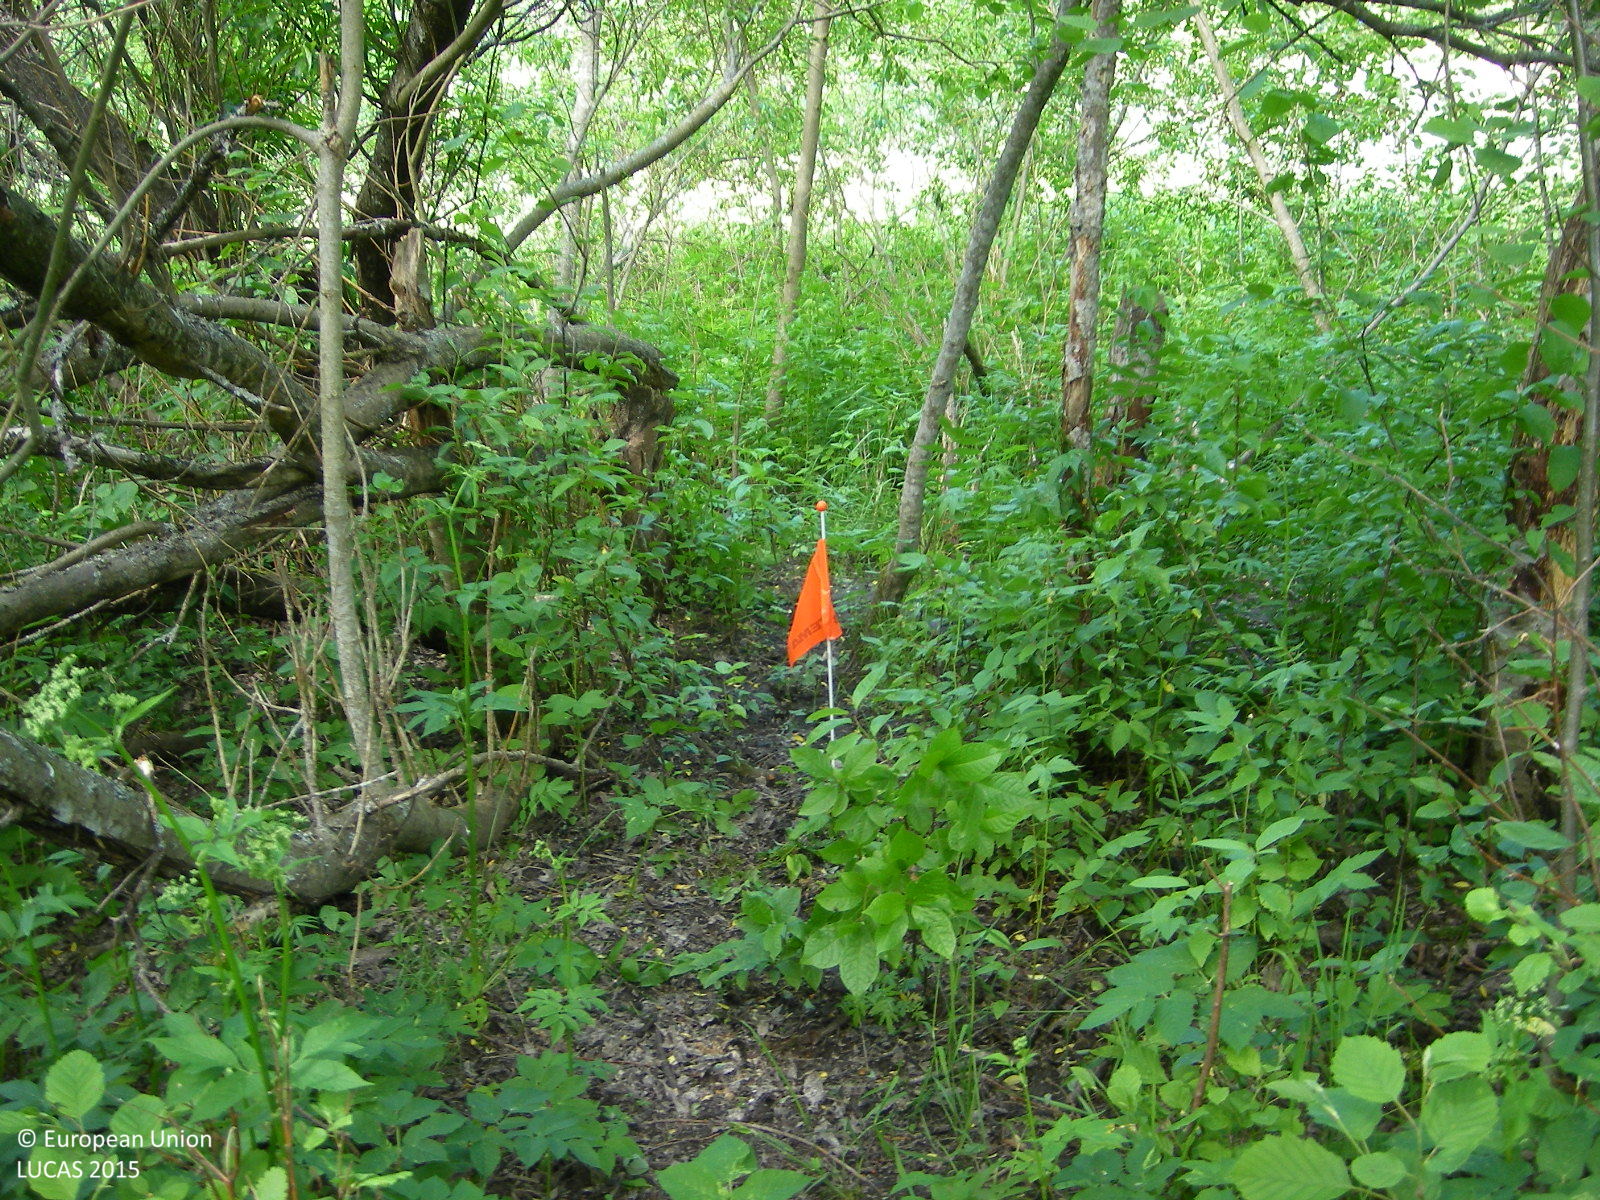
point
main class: Woodland
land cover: Broadleaved woodland
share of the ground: > 75 %
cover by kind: broadleaved forest trees 100 %
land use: Forestry
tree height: > 5 m
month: June
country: FI
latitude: 60.3821
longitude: 23.9363
